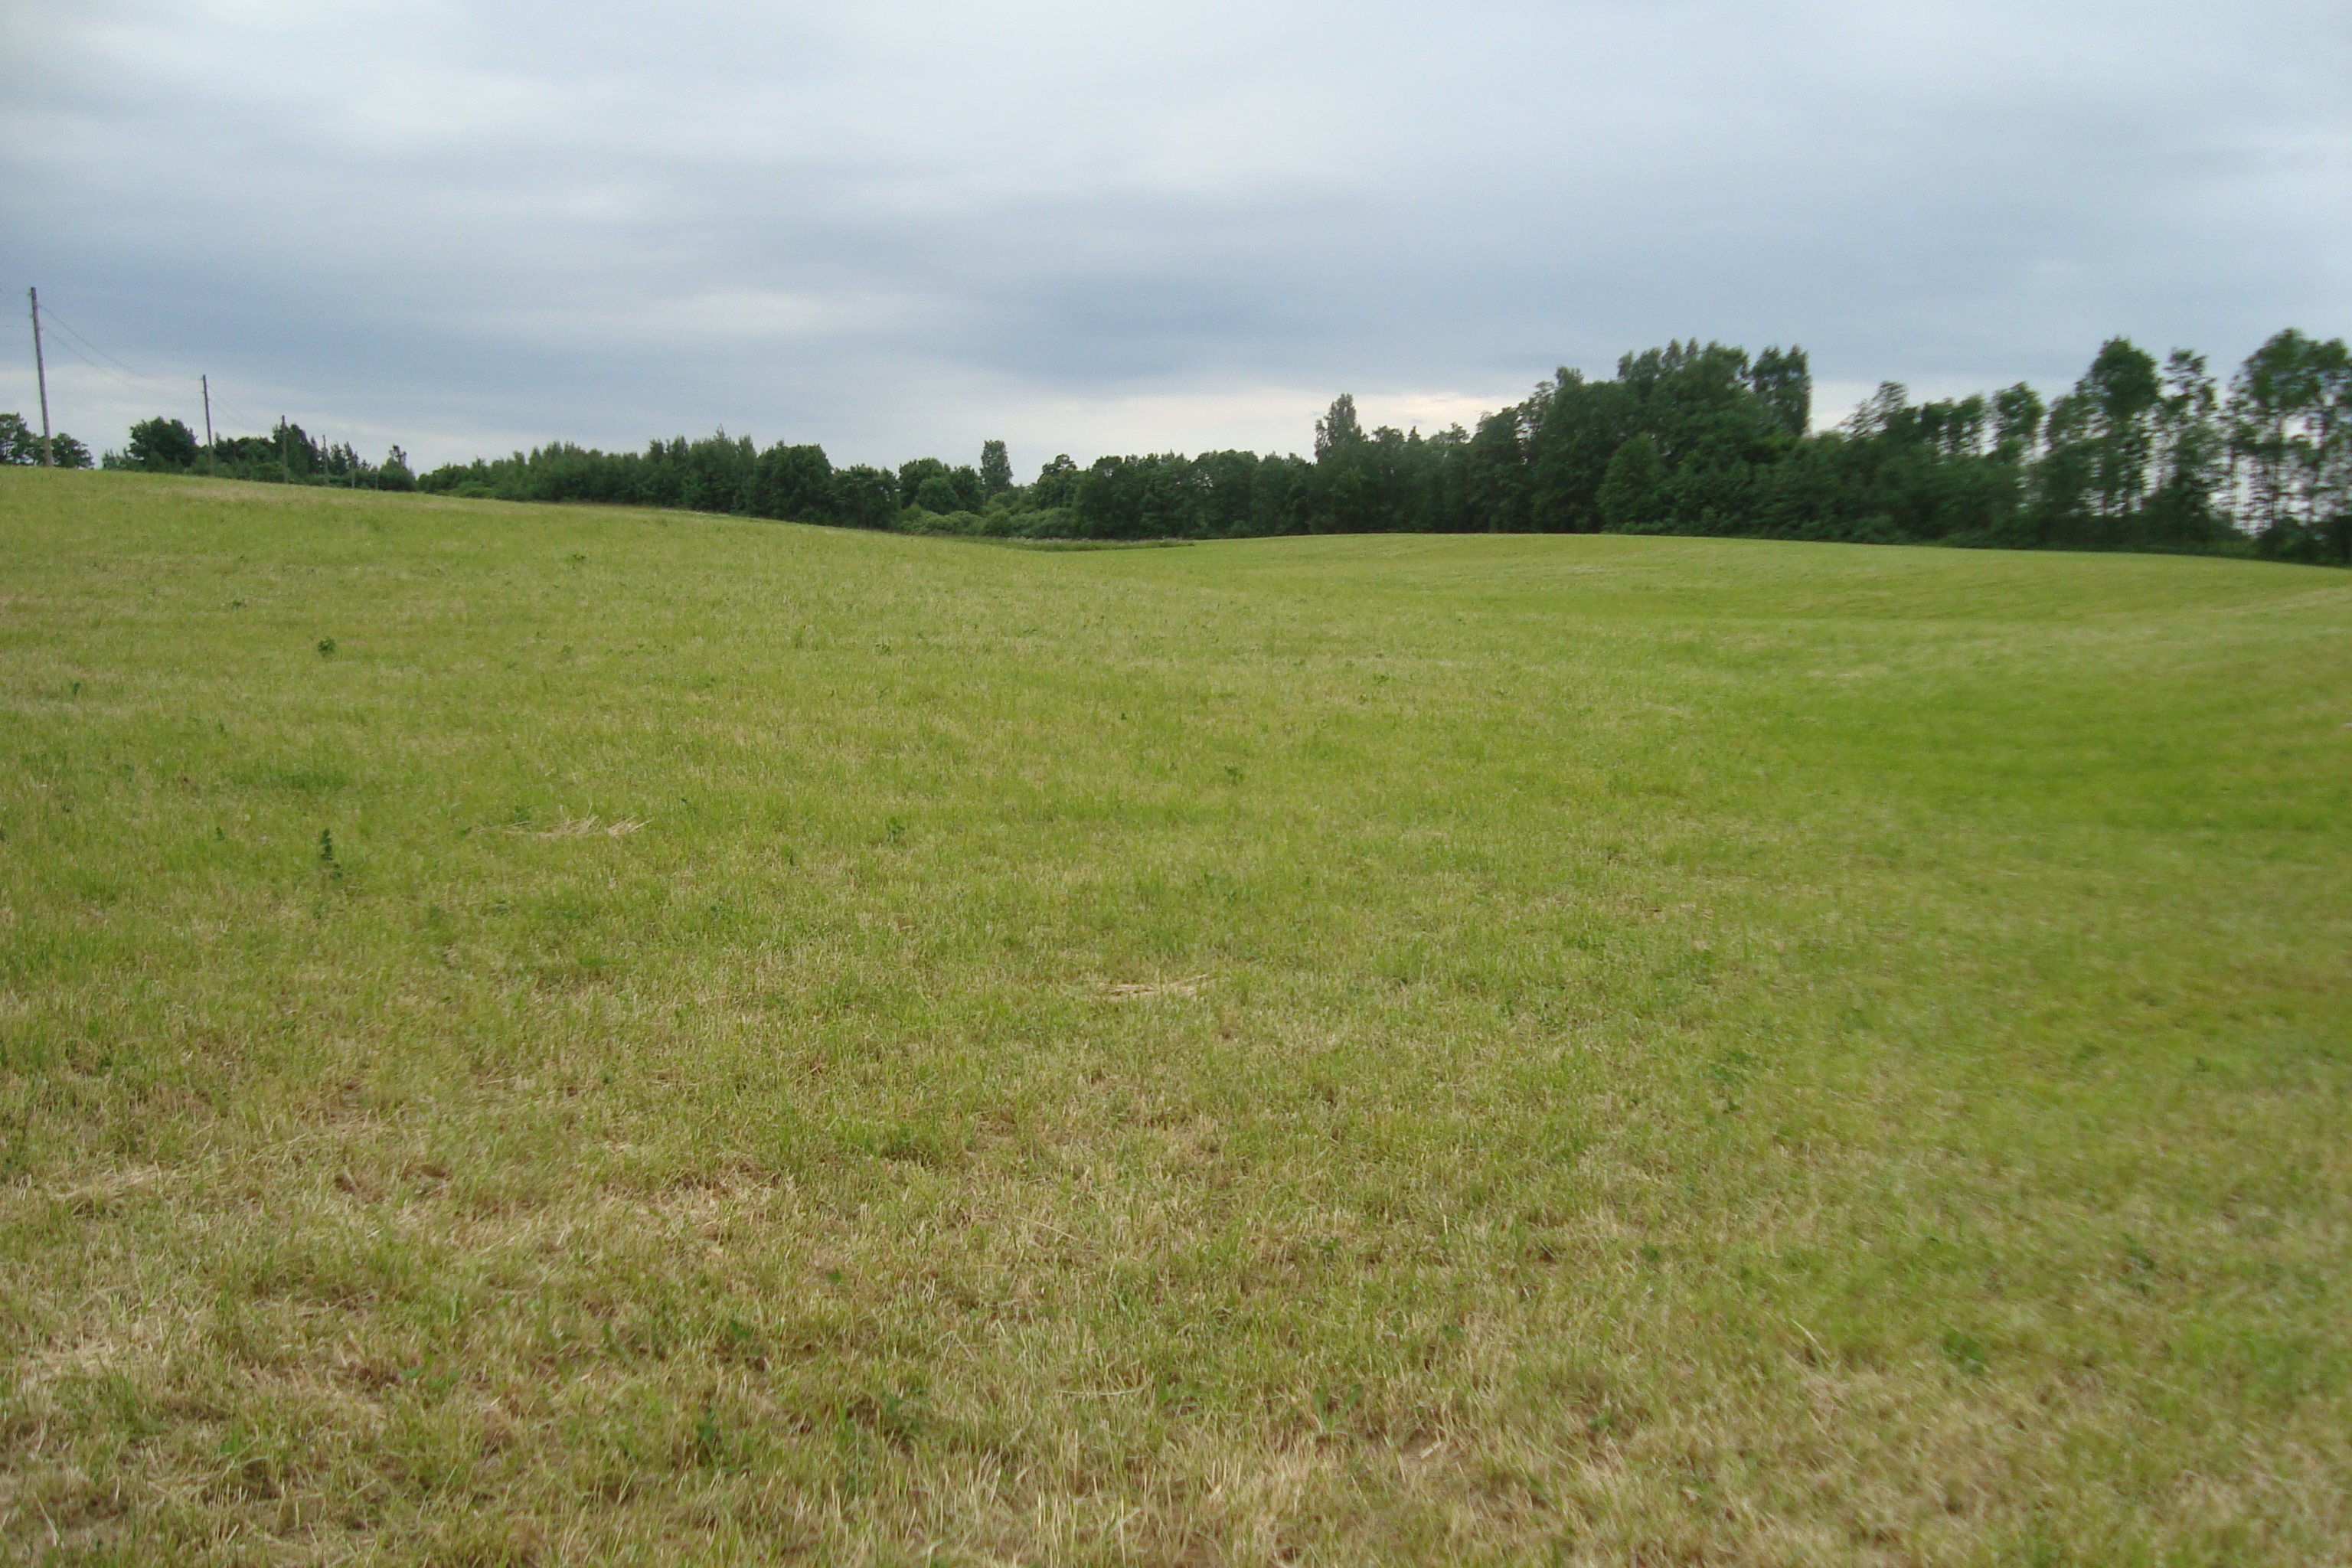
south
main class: Grassland
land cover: Grassland without tree/shrub cover
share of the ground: > 75 %
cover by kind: herbaceous plants 100 %
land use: Agriculture (excluding fallow land and kitchen gardens)
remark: Harvested field
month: June
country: LV
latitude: 57.1823
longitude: 26.4040
